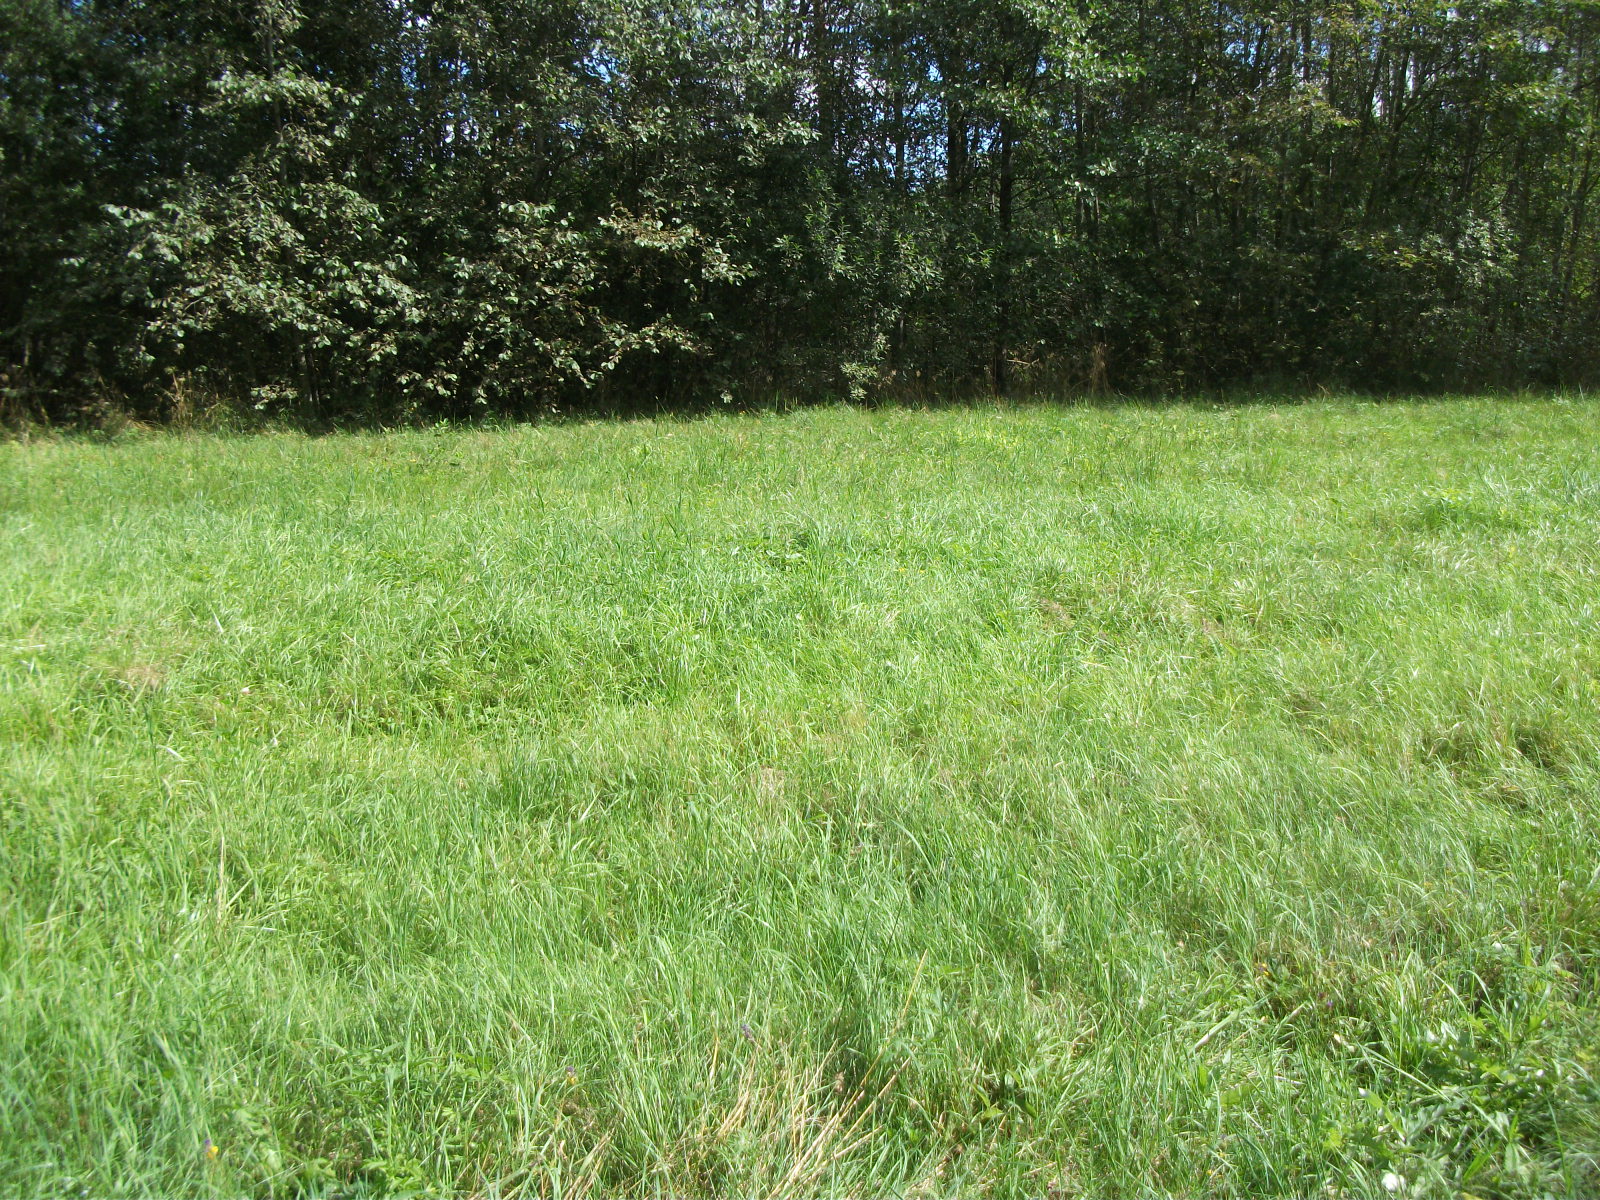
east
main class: Grassland
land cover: Grassland without tree/shrub cover
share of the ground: > 75 %
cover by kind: herbaceous plants 100 %
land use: Agriculture (excluding fallow land and kitchen gardens)
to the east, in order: Grassland without tree/shrub cover; Broadleaved woodland
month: August
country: LV
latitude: 56.5663
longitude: 26.4692
